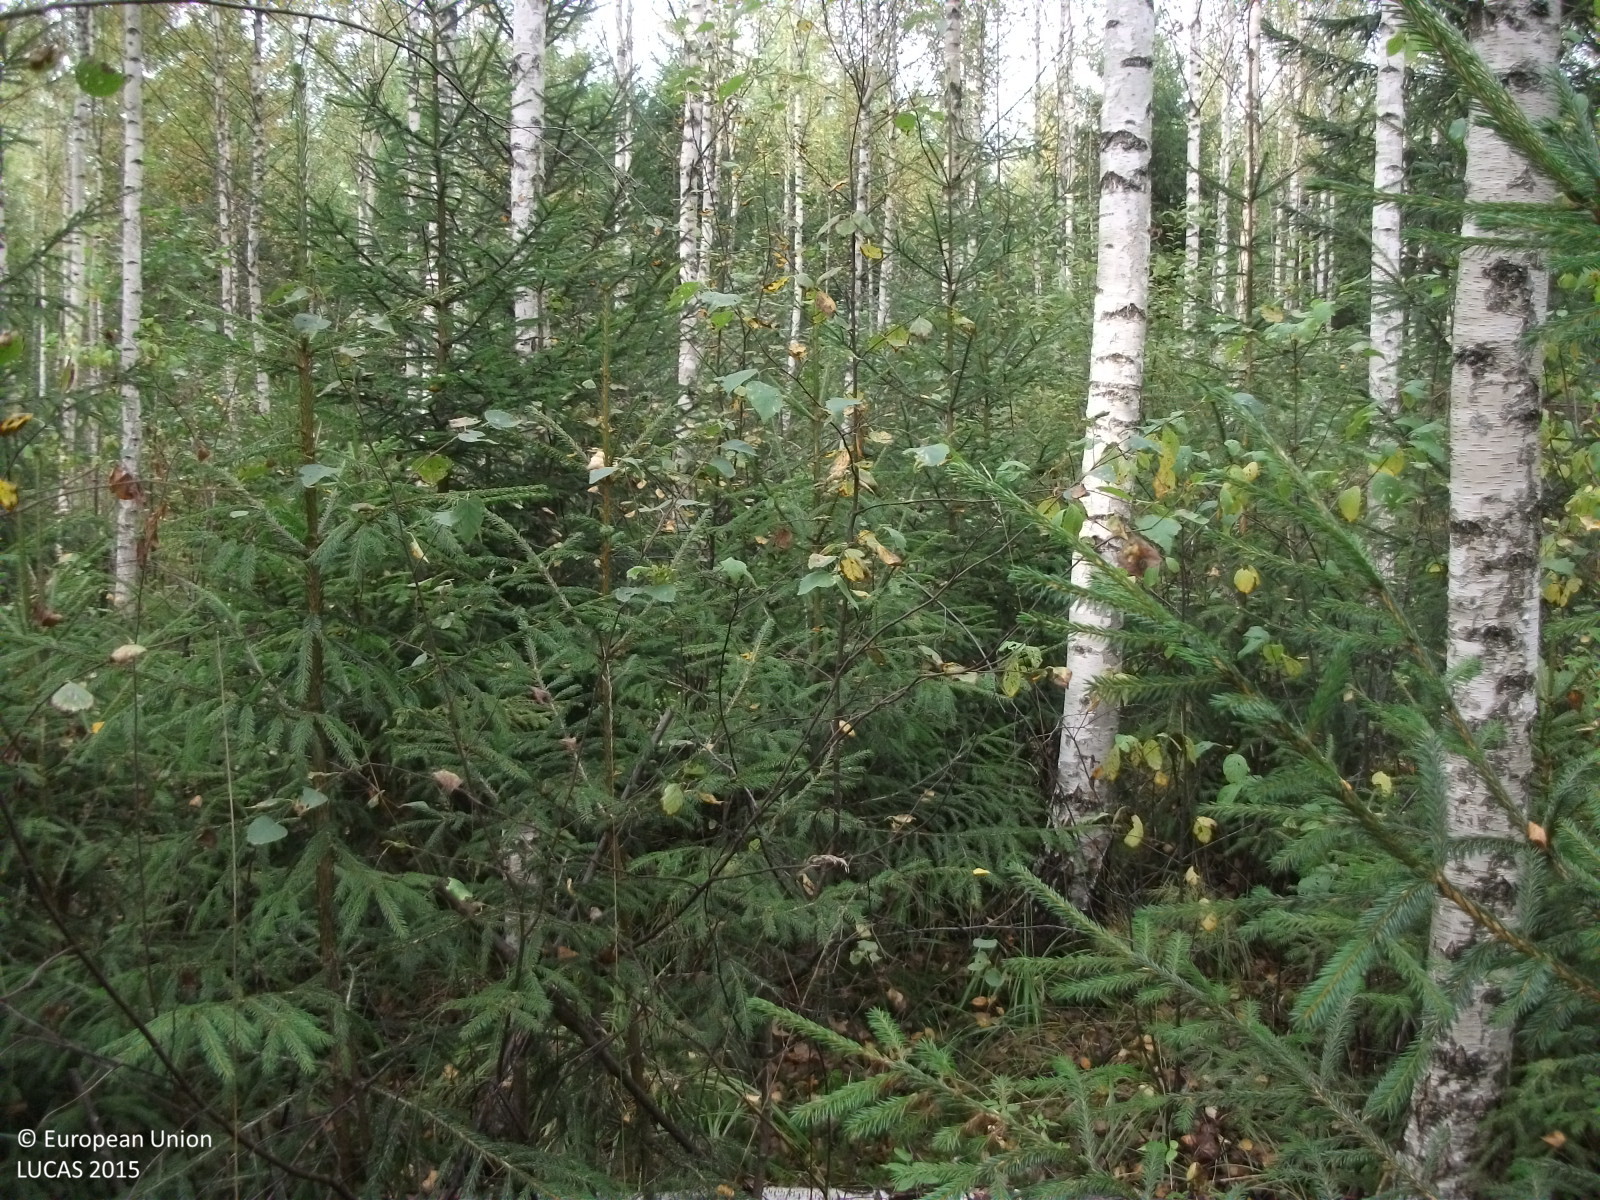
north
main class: Woodland
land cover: Spruce dominated mixed woodland
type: hemiboreal forest and nemoral coniferous forest and mixed broadleaved-coniferous forest
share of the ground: > 75 %
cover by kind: broadleaved forest trees 50 %, coniferous forest trees 30 %, herbaceous plants 10 %, shrubs 5 %, unconsolidated bare surface 5 %
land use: Forestry
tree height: > 5 m
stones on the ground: < 10 %
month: September
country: LV
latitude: 57.7424
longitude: 24.7953
